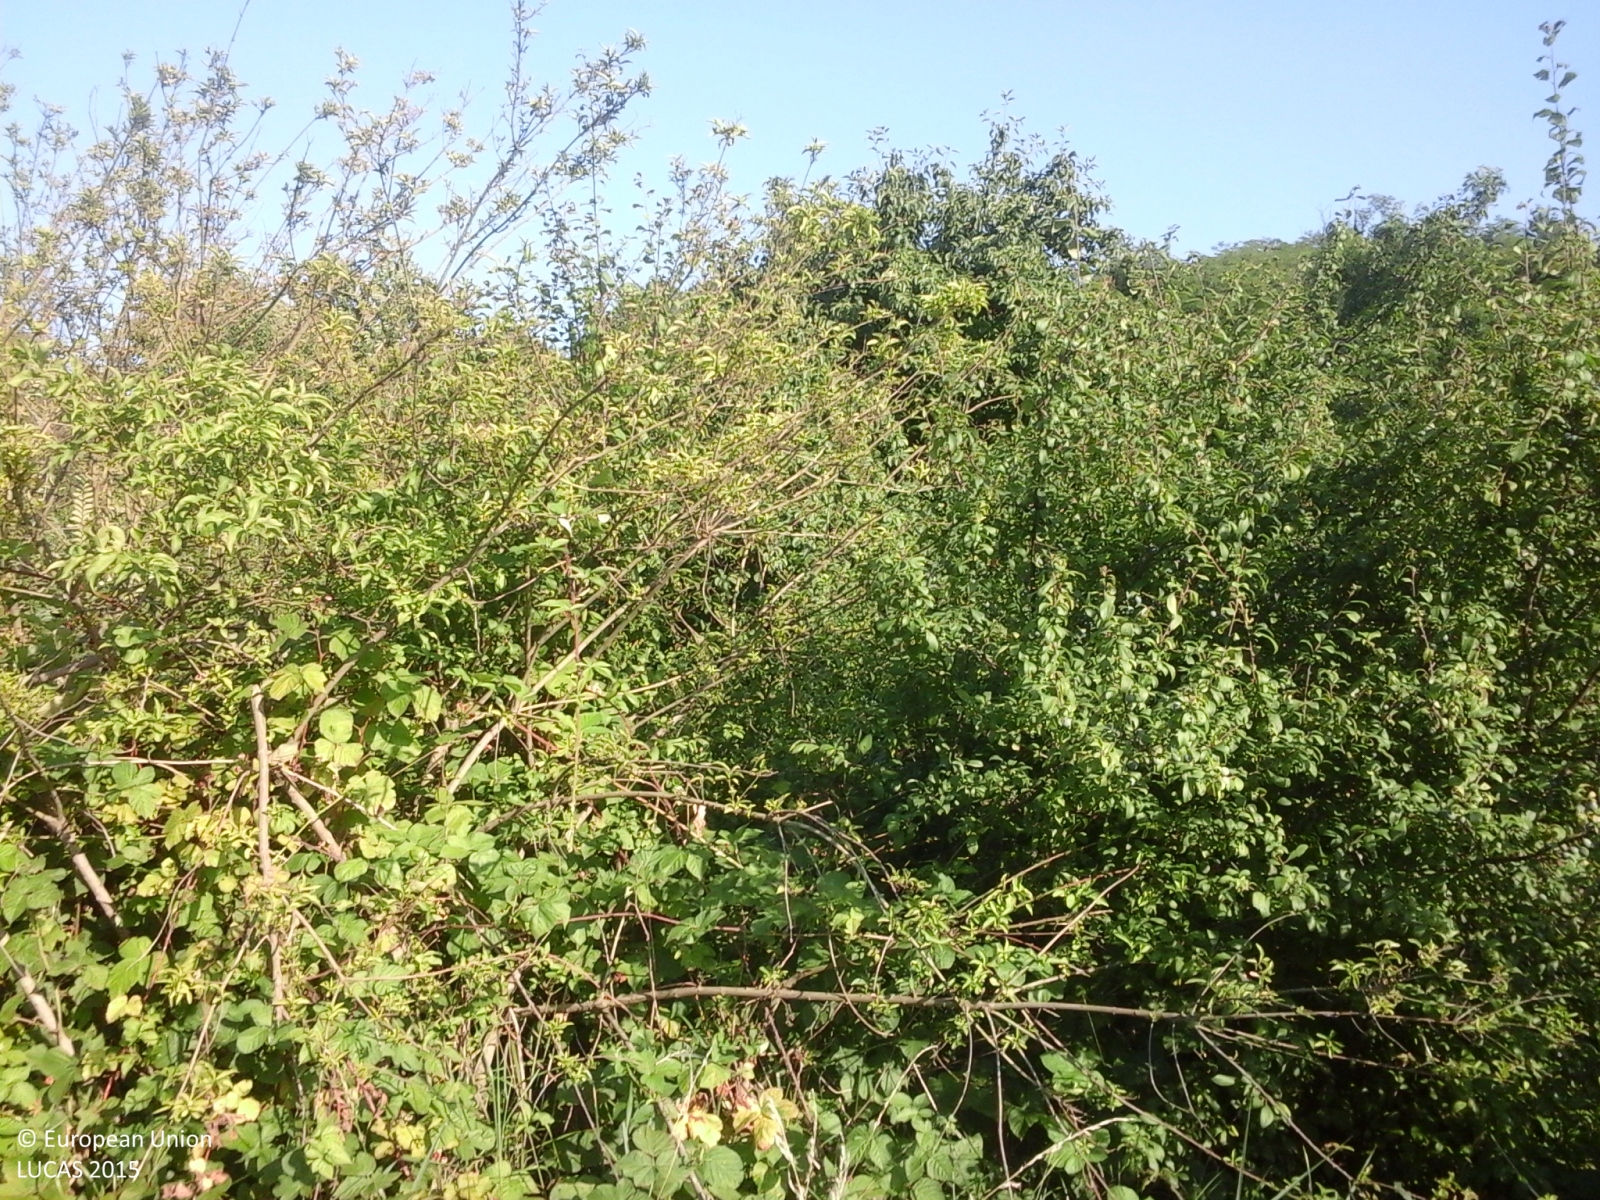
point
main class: Woodland
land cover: Broadleaved woodland
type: thermophilous deciduous forest
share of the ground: > 75 %
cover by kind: broadleaved forest trees 90 %, shrubs 10 %
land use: Semi-natural and natural areas not in use
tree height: > 5 m
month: June
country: IT
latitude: 44.9729
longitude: 8.6459
